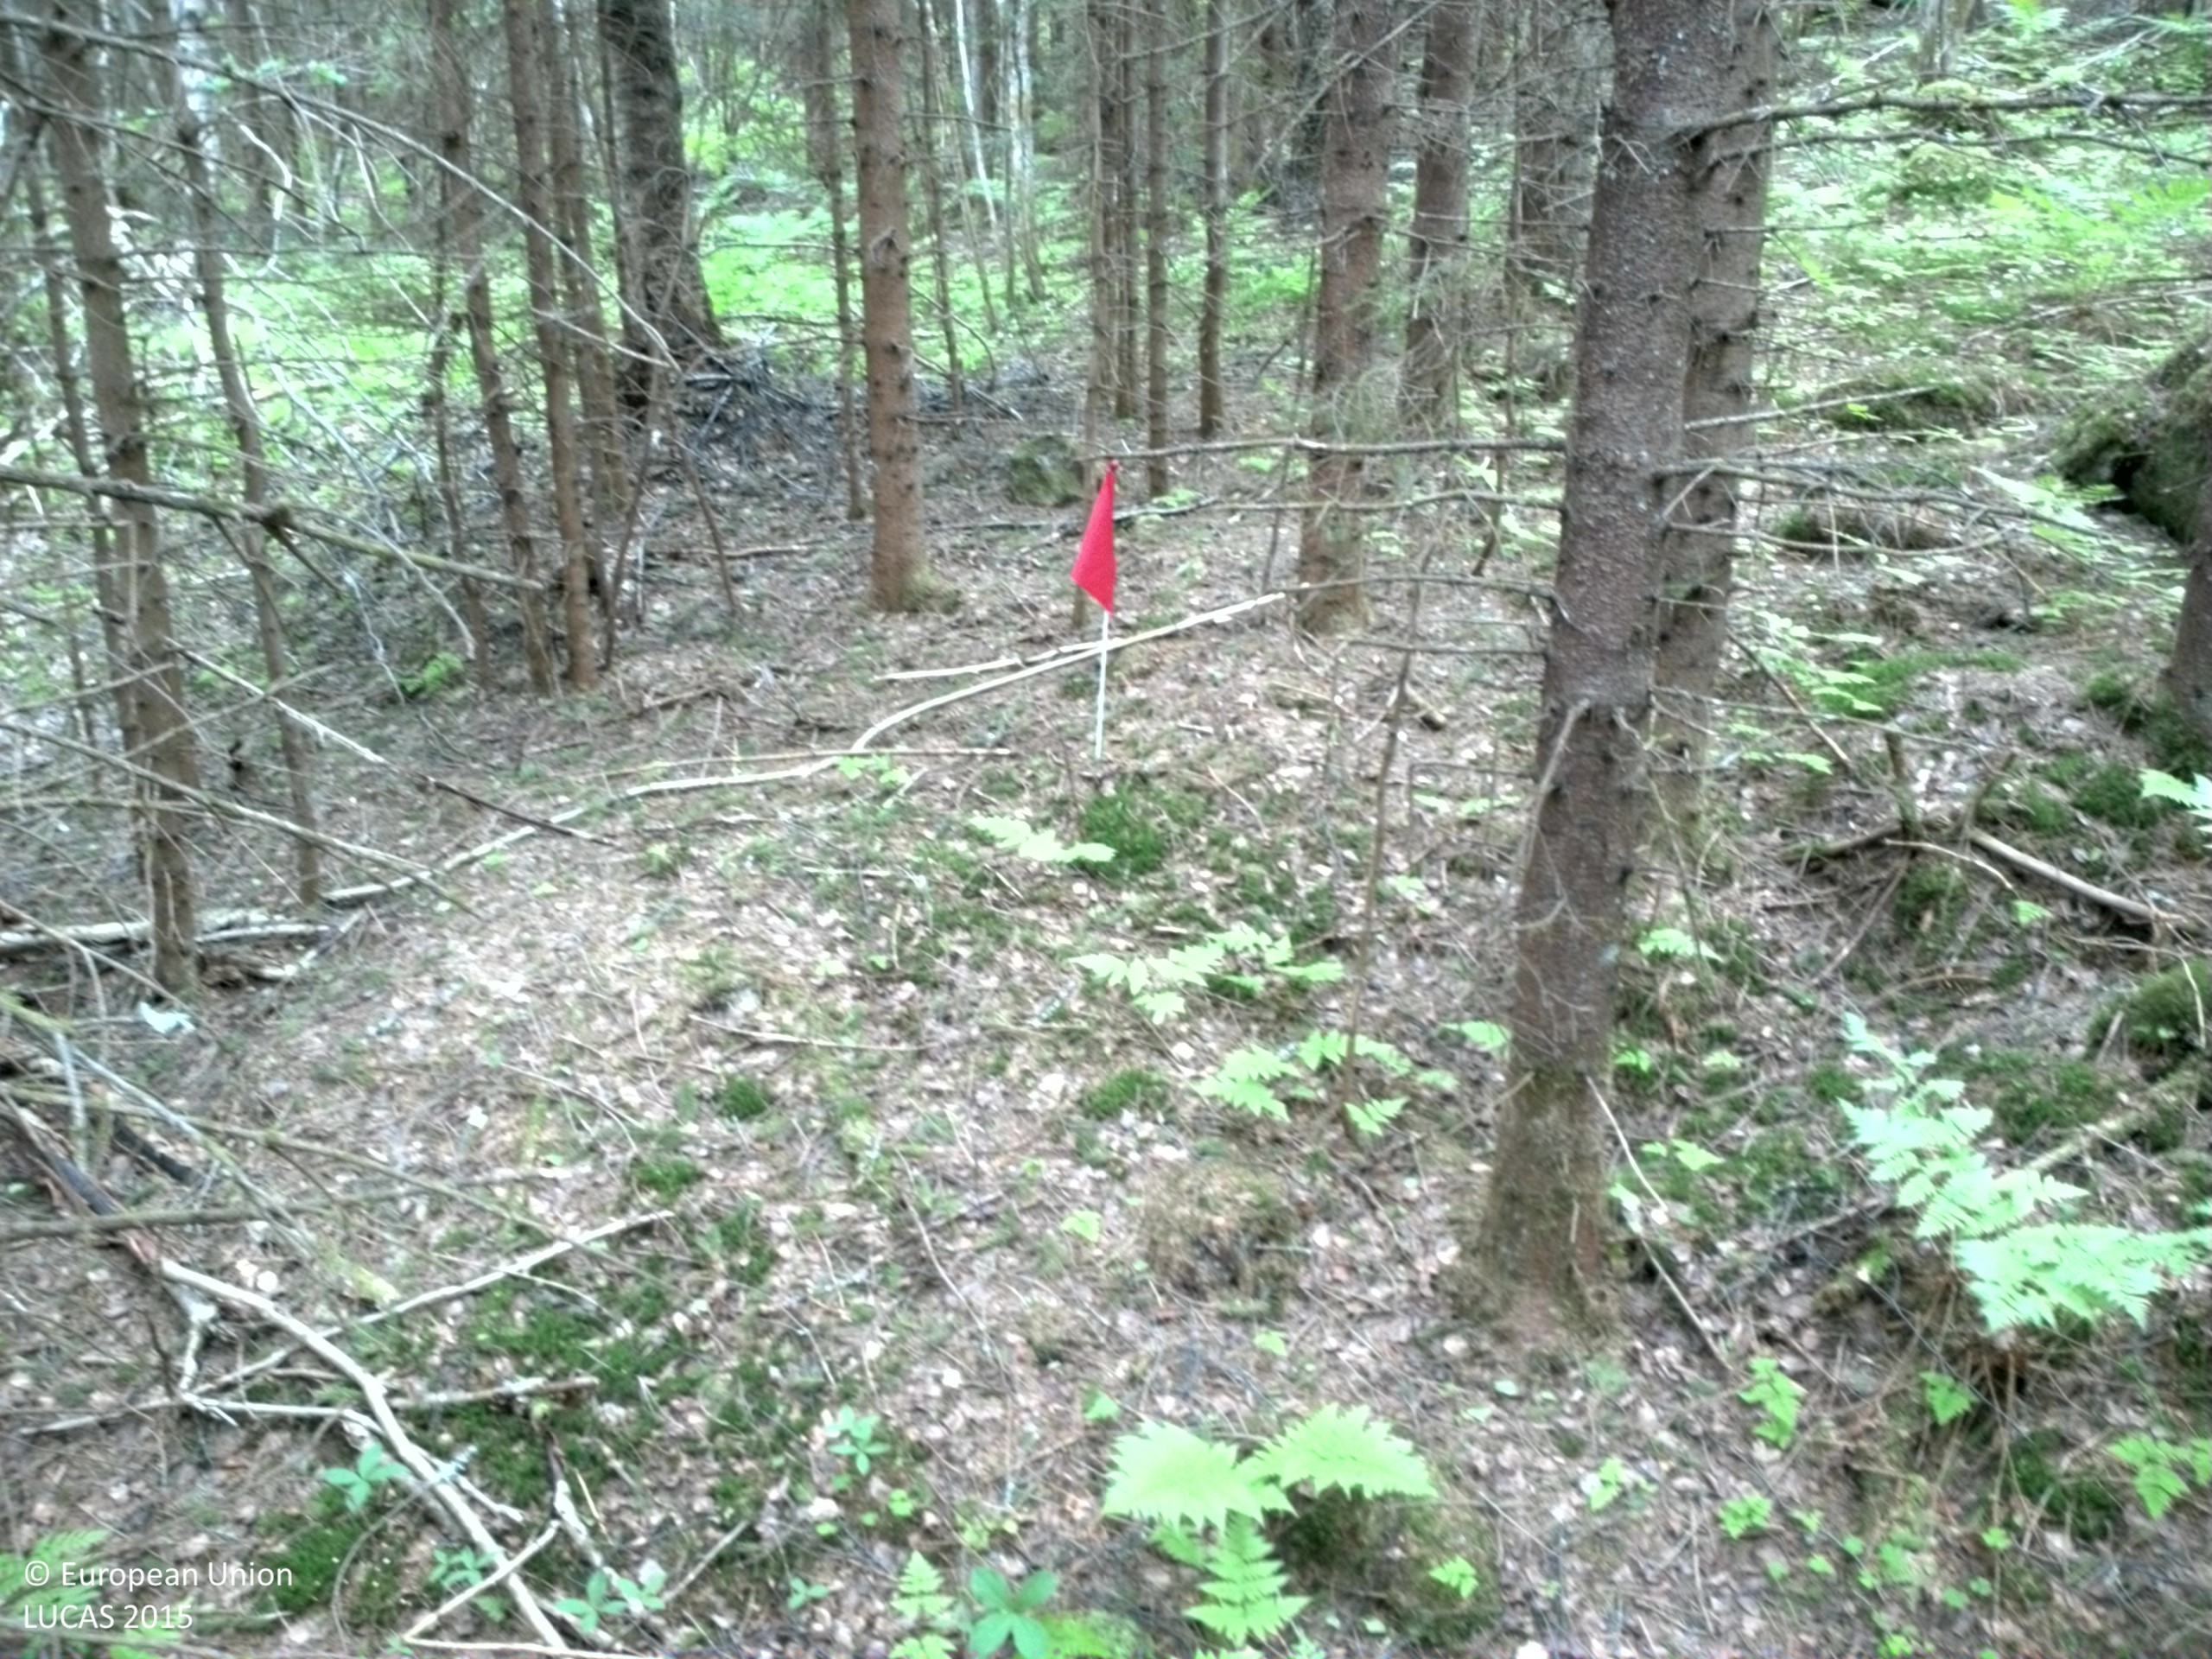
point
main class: Woodland
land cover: Spruce dominated coniferous woodland
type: boreal forest
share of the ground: > 75 %
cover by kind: coniferous forest trees 80 %, lichens and mosses 15 %, herbaceous plants 5 %
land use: Forestry
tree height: > 5 m
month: June
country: SE
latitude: 62.9438
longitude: 17.9987
